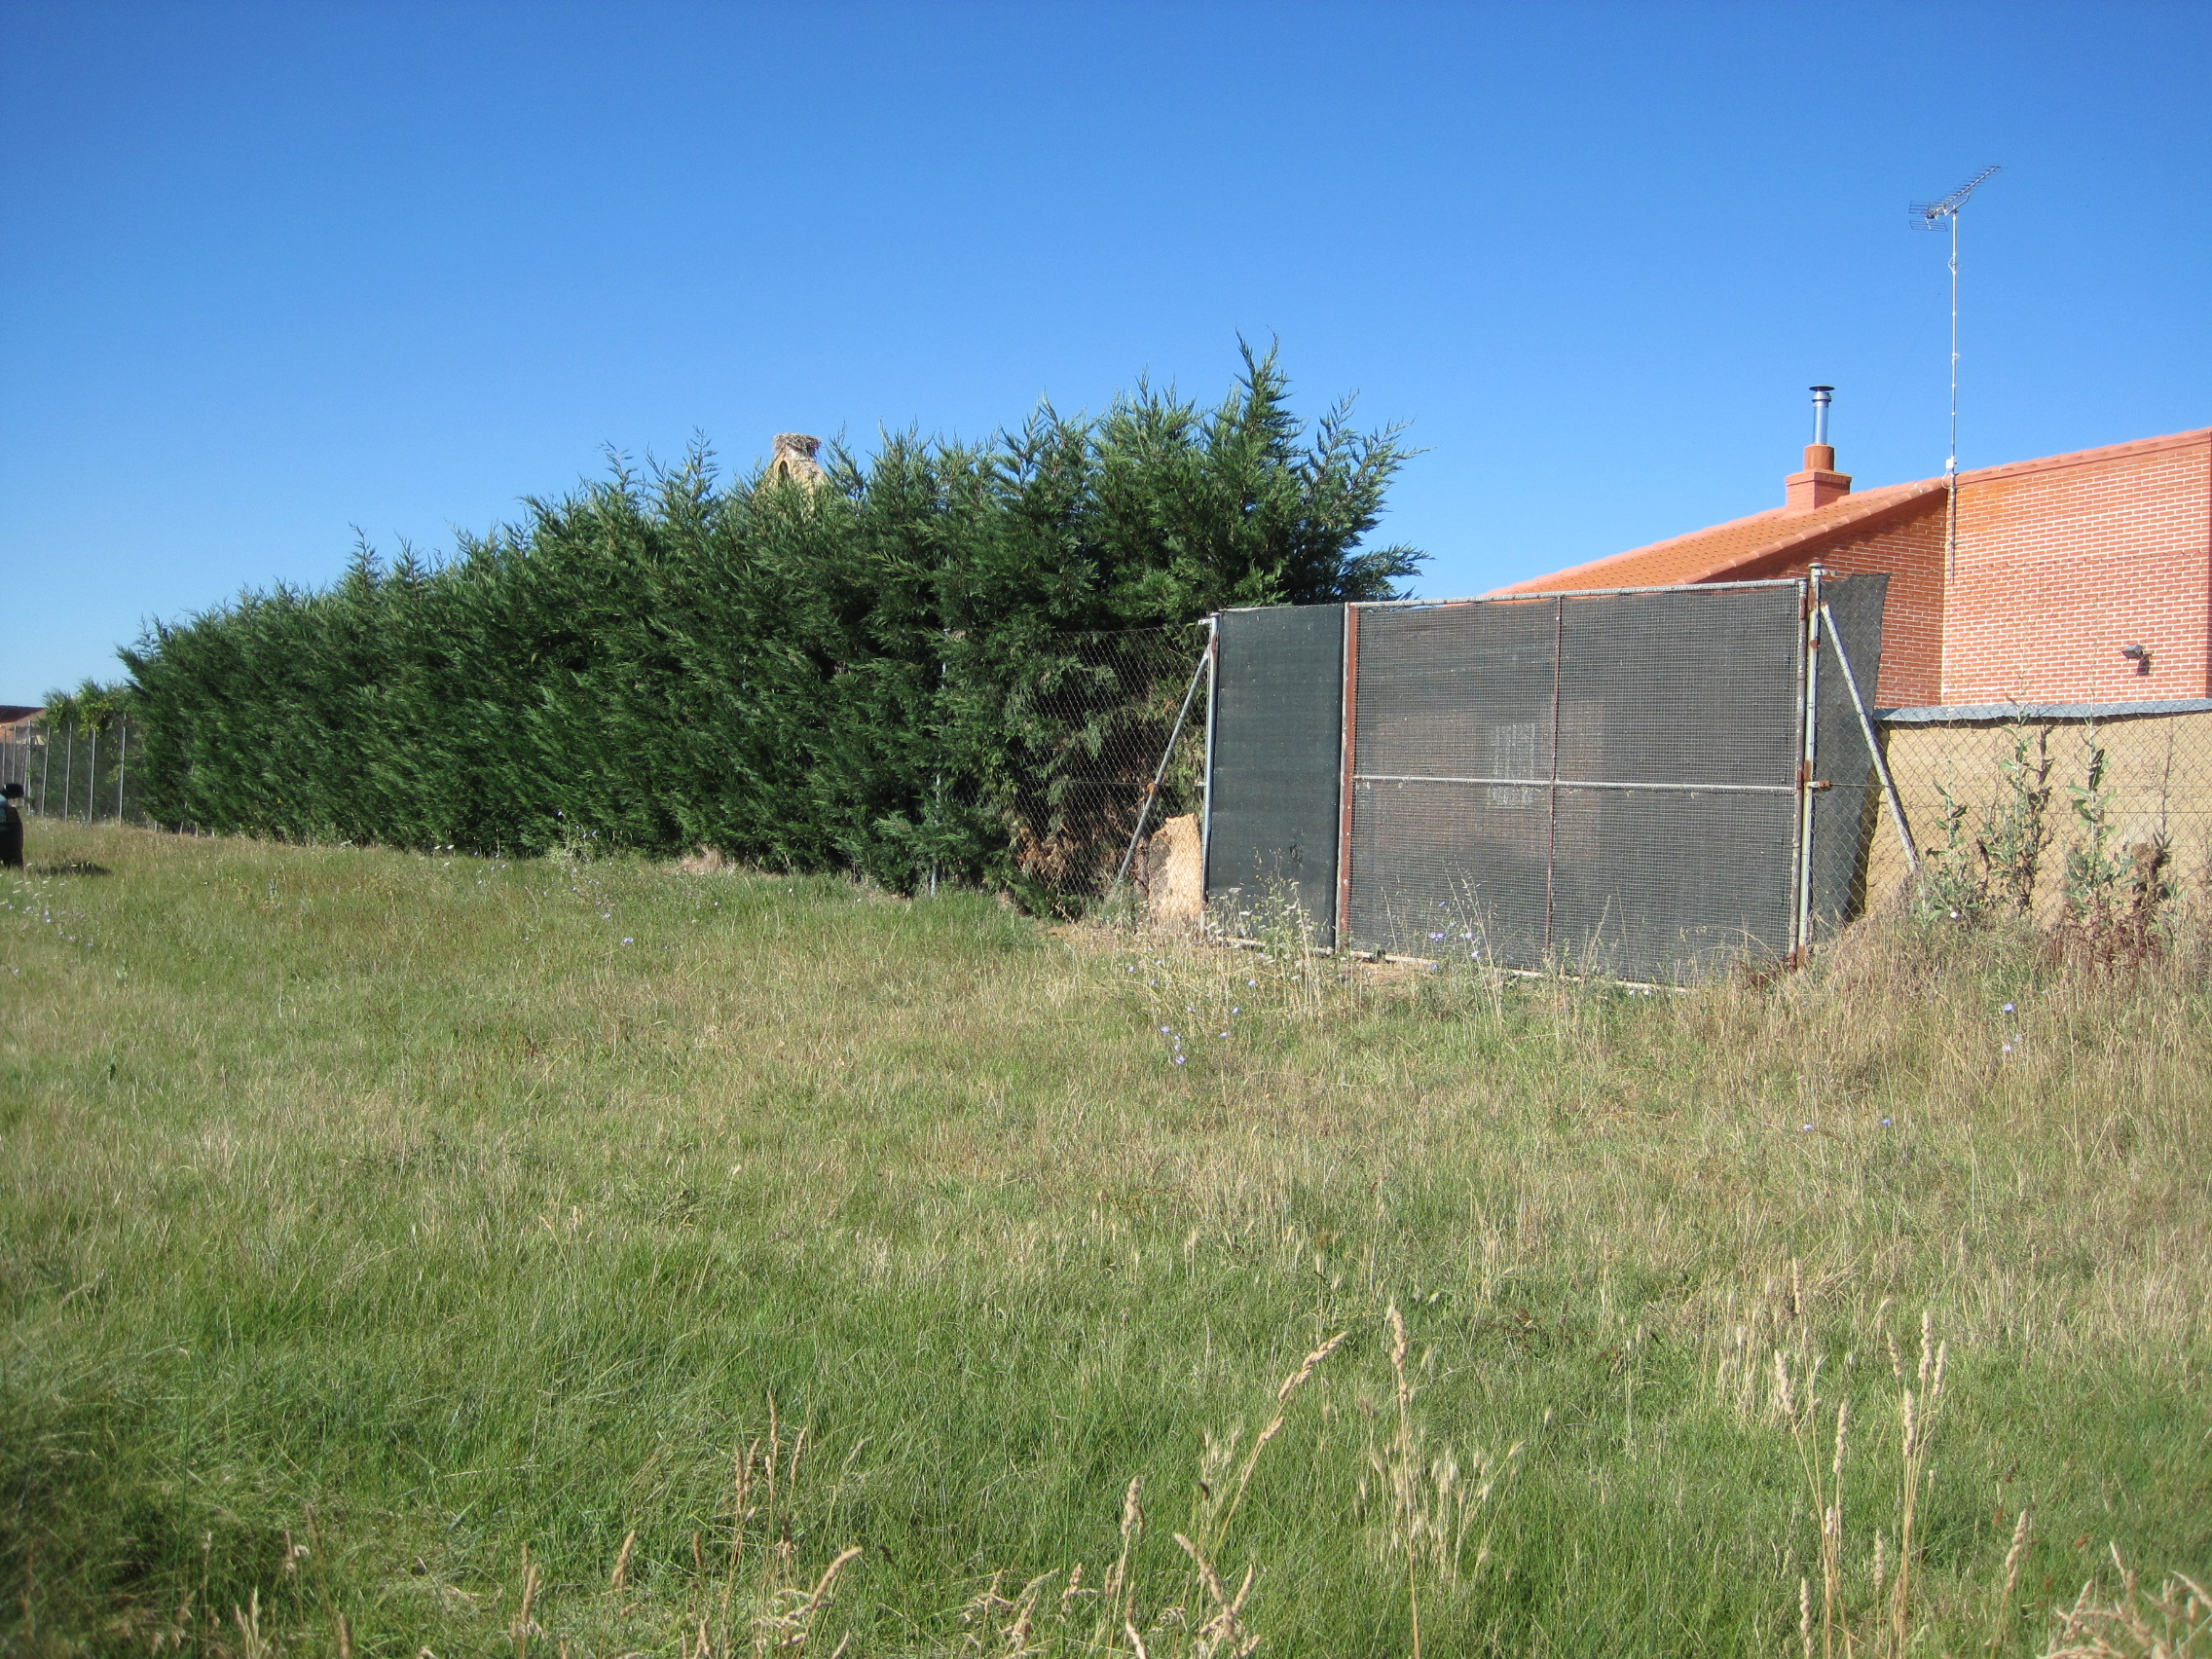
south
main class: Grassland
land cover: Grassland without tree/shrub cover
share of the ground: > 75 %
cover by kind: herbaceous plants 100 %
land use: Semi-natural and natural areas not in use
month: July
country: ES
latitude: 42.0793
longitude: -5.5998
